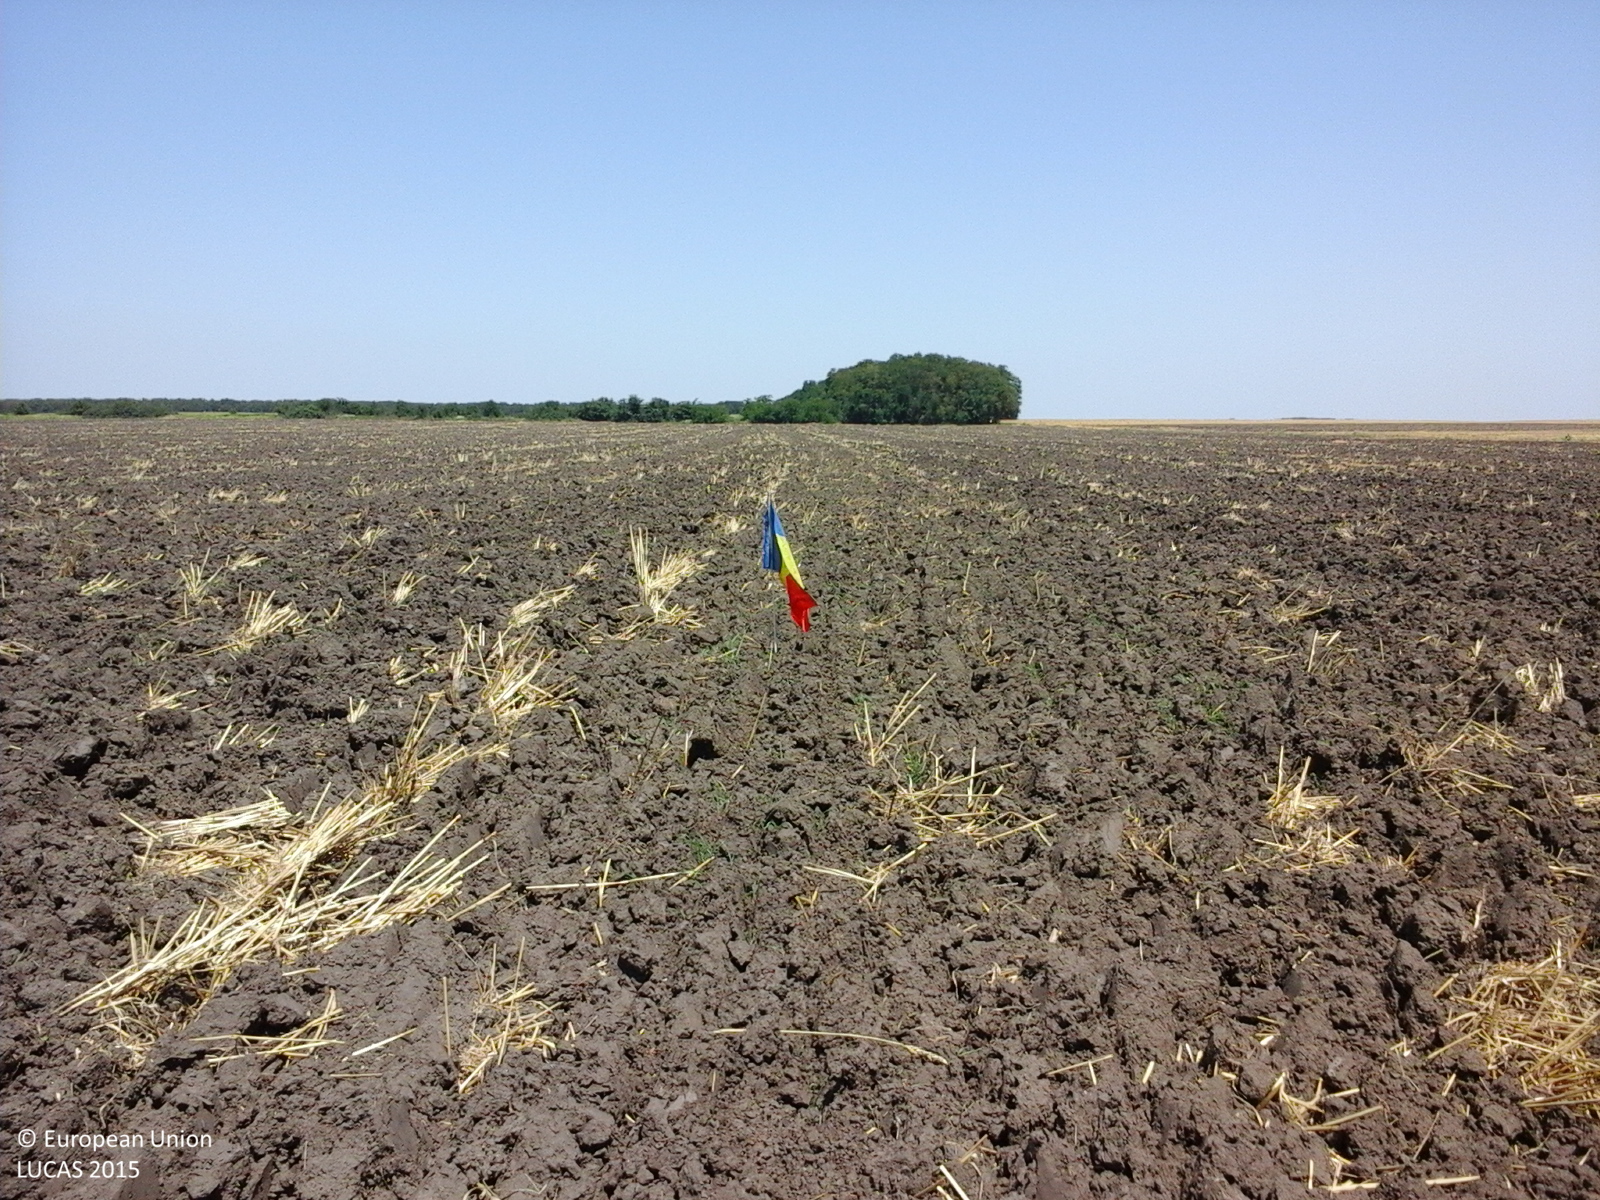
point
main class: Cropland
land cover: Common wheat
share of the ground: < 10 %
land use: Agriculture (excluding fallow land and kitchen gardens)
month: July
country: RO
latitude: 44.2817
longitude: 26.6446
